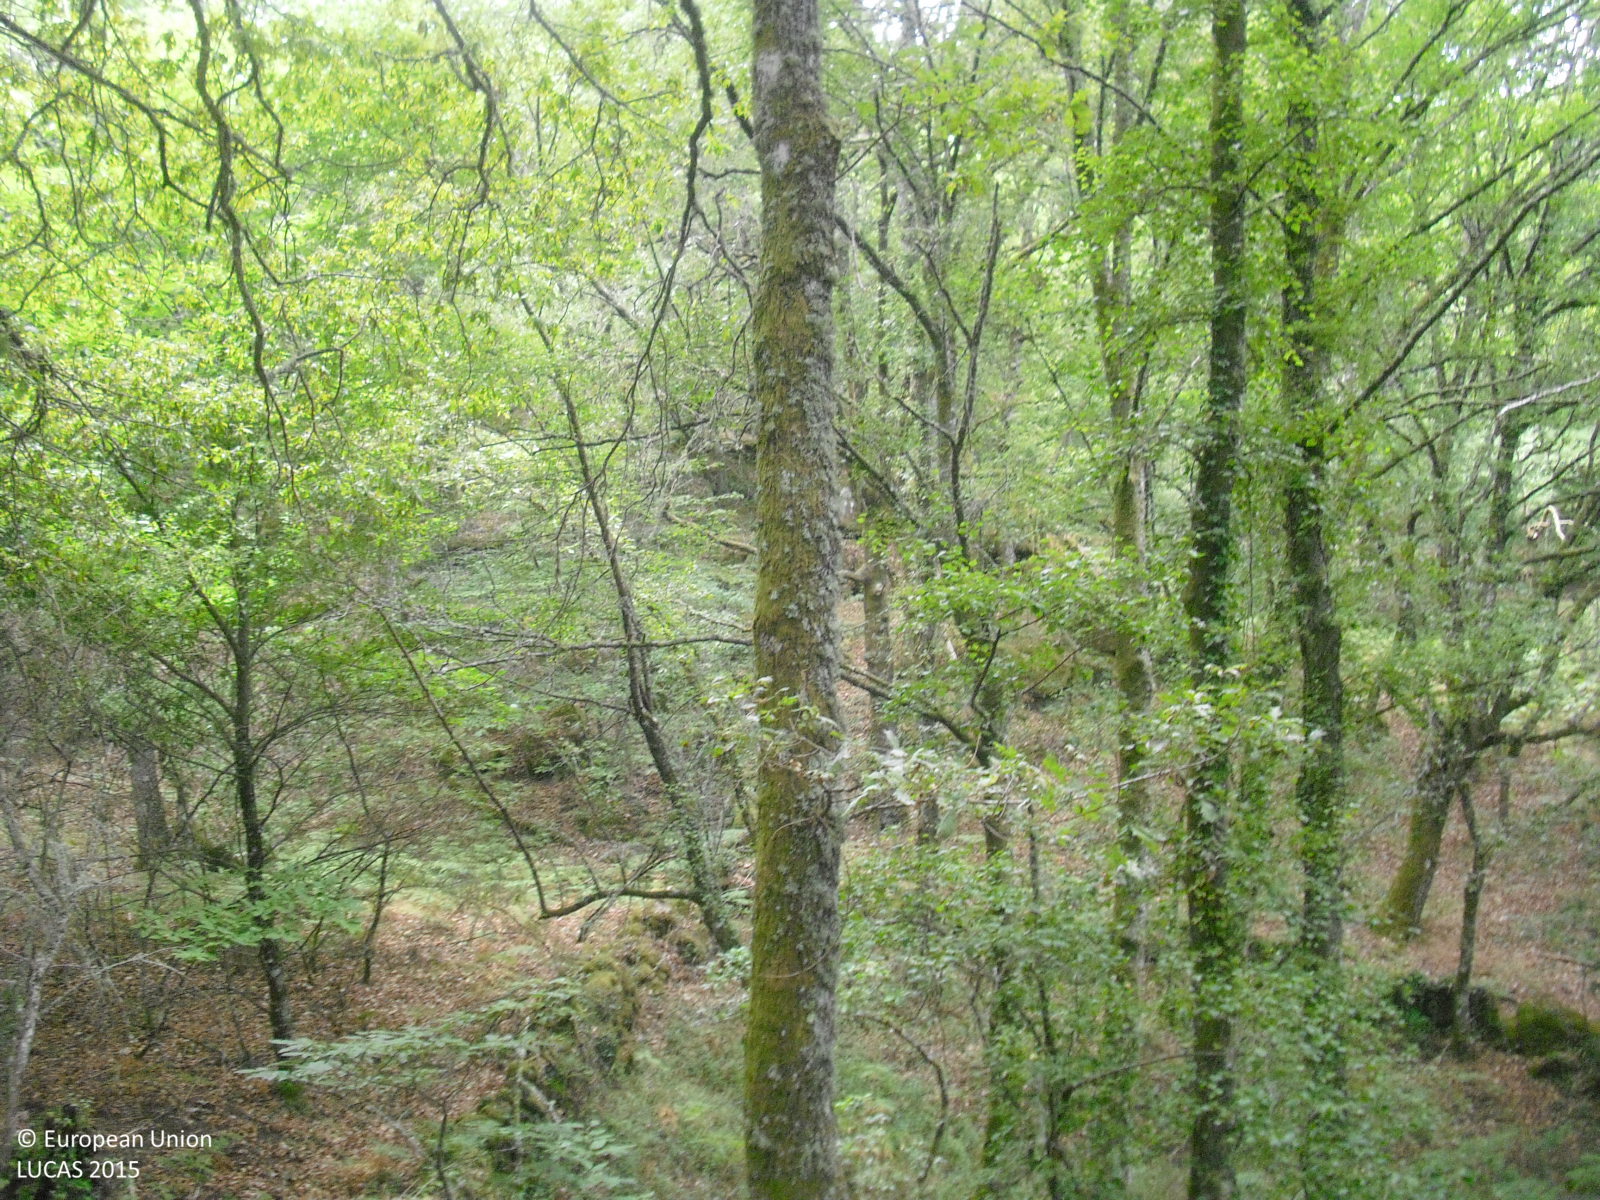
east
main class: Woodland
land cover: Broadleaved woodland
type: thermophilous deciduous forest
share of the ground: > 75 %
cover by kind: broadleaved forest trees 90 %, shrubs 10 %
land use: Forestry
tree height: > 5 m
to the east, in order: Broadleaved woodland; Rivers and streams; Broadleaved woodland; Dry stone walls; Broadleaved woodland; Rock outcrops; Broadleaved woodland; Rivers and streams; Broadleaved woodland; Rock outcrops; Broadleaved woodland; Dry stone walls; Broadleaved woodland; Rock outcrops; Shrubland with sparse tree cover
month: July
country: ES
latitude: 42.3901
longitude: -7.6989
